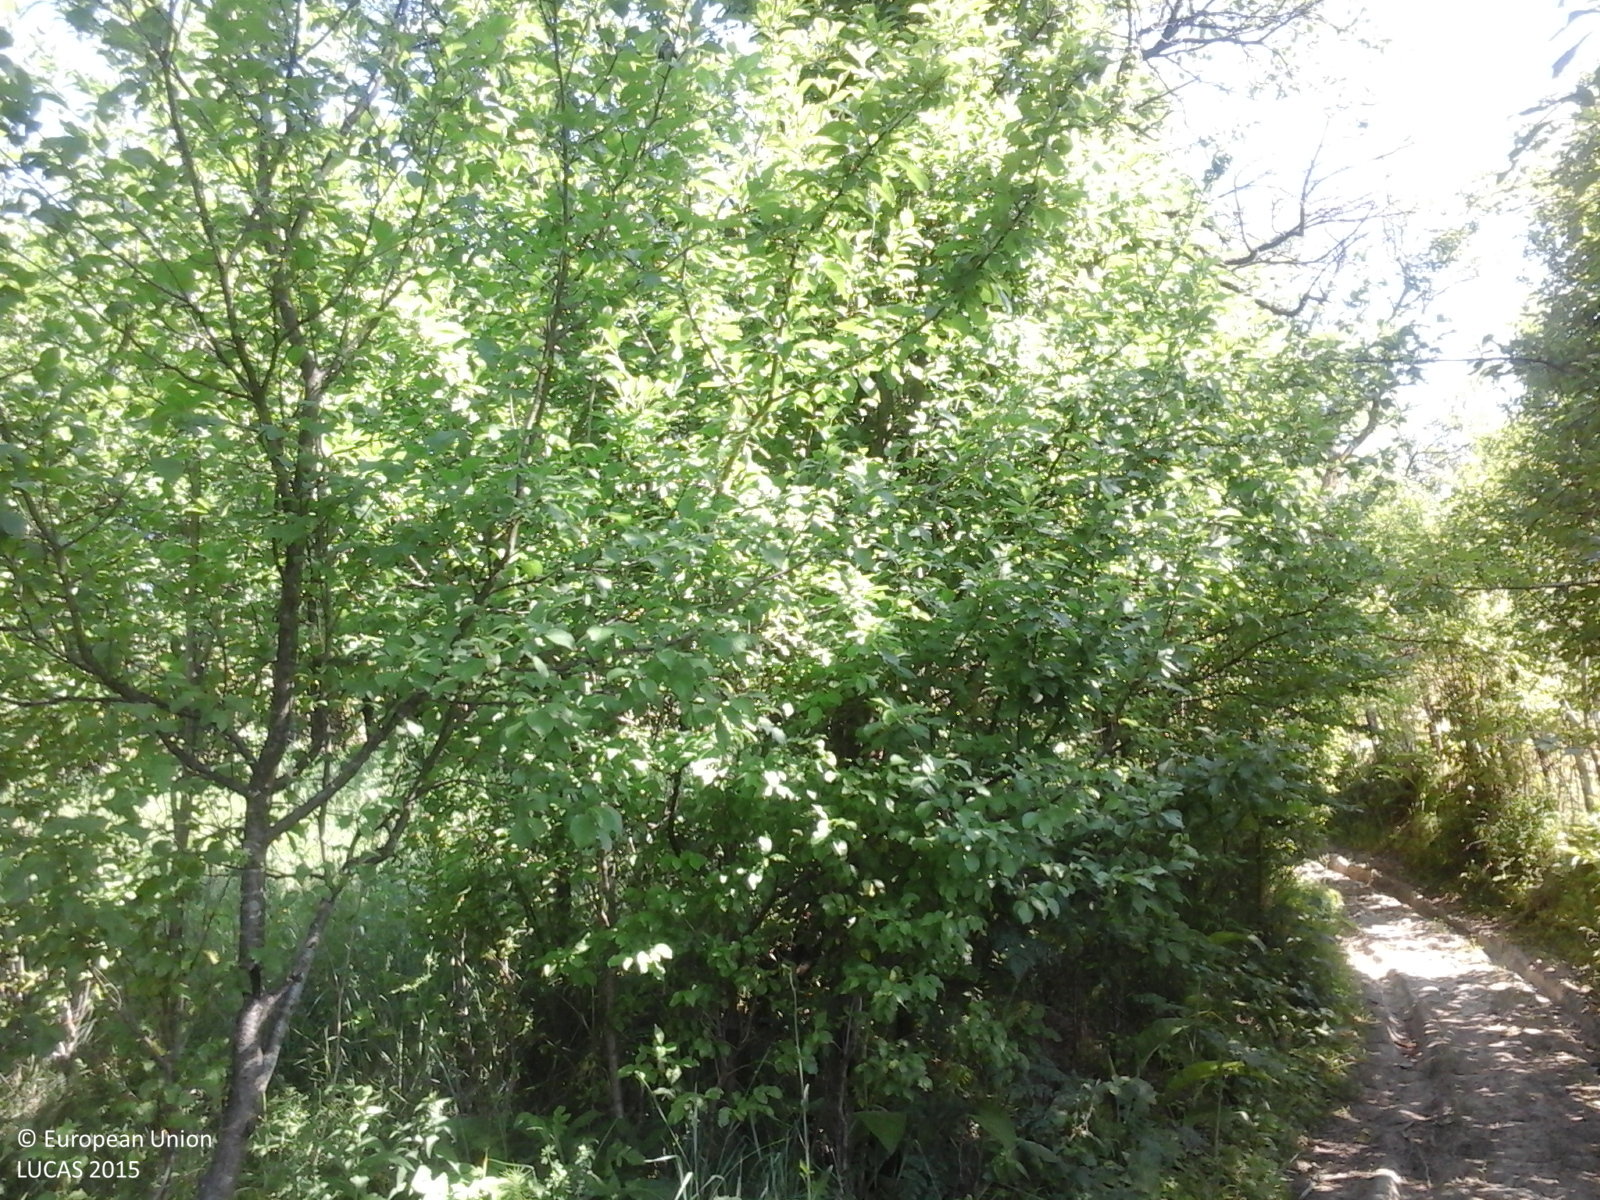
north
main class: Cropland
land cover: Vineyards
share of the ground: 50 - 75 %
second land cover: Grassland without tree/shrub cover
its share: 10 - 25 %
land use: Agriculture (excluding fallow land and kitchen gardens)
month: June
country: RO
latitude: 46.3741
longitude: 26.6608
